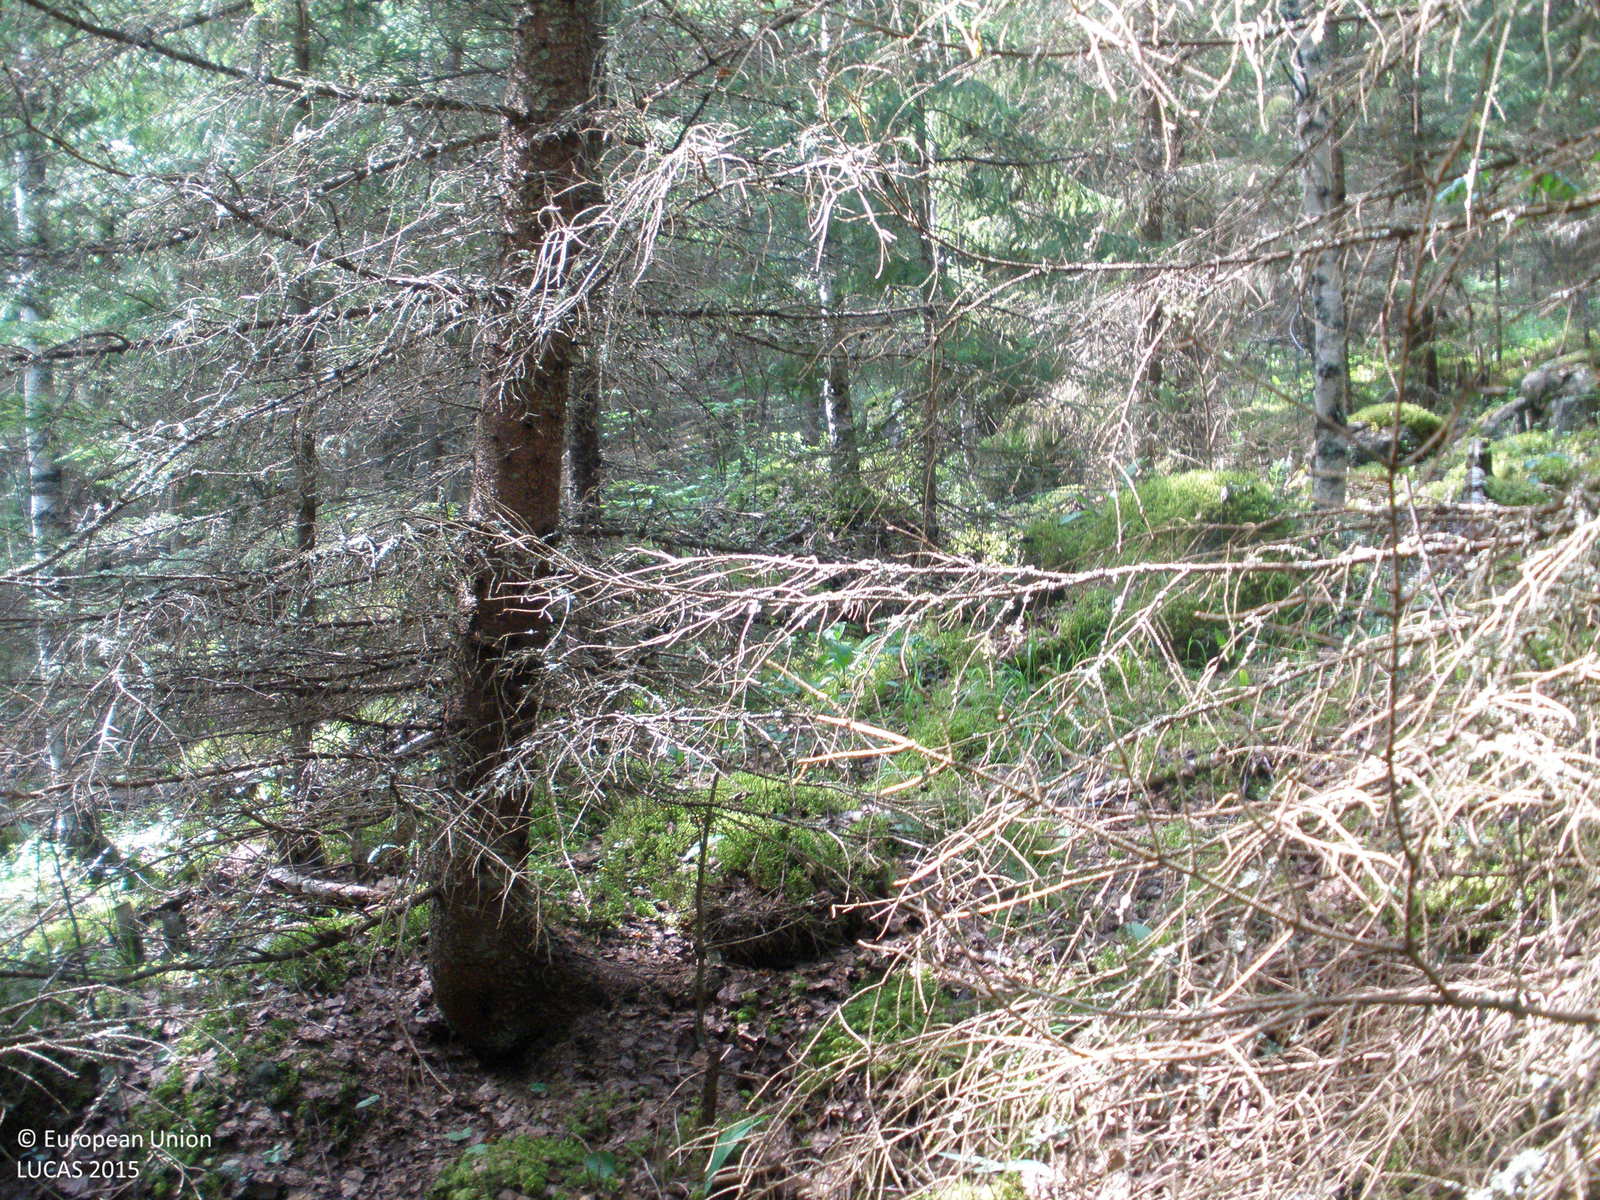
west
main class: Woodland
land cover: Spruce dominated mixed woodland
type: boreal forest
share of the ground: > 75 %
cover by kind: coniferous forest trees 60 %, broadleaved forest trees 25 %, lichens and mosses 10 %, herbaceous plants 5 %
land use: Forestry
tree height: > 5 m
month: July
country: FI
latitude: 61.3569
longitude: 23.9079
